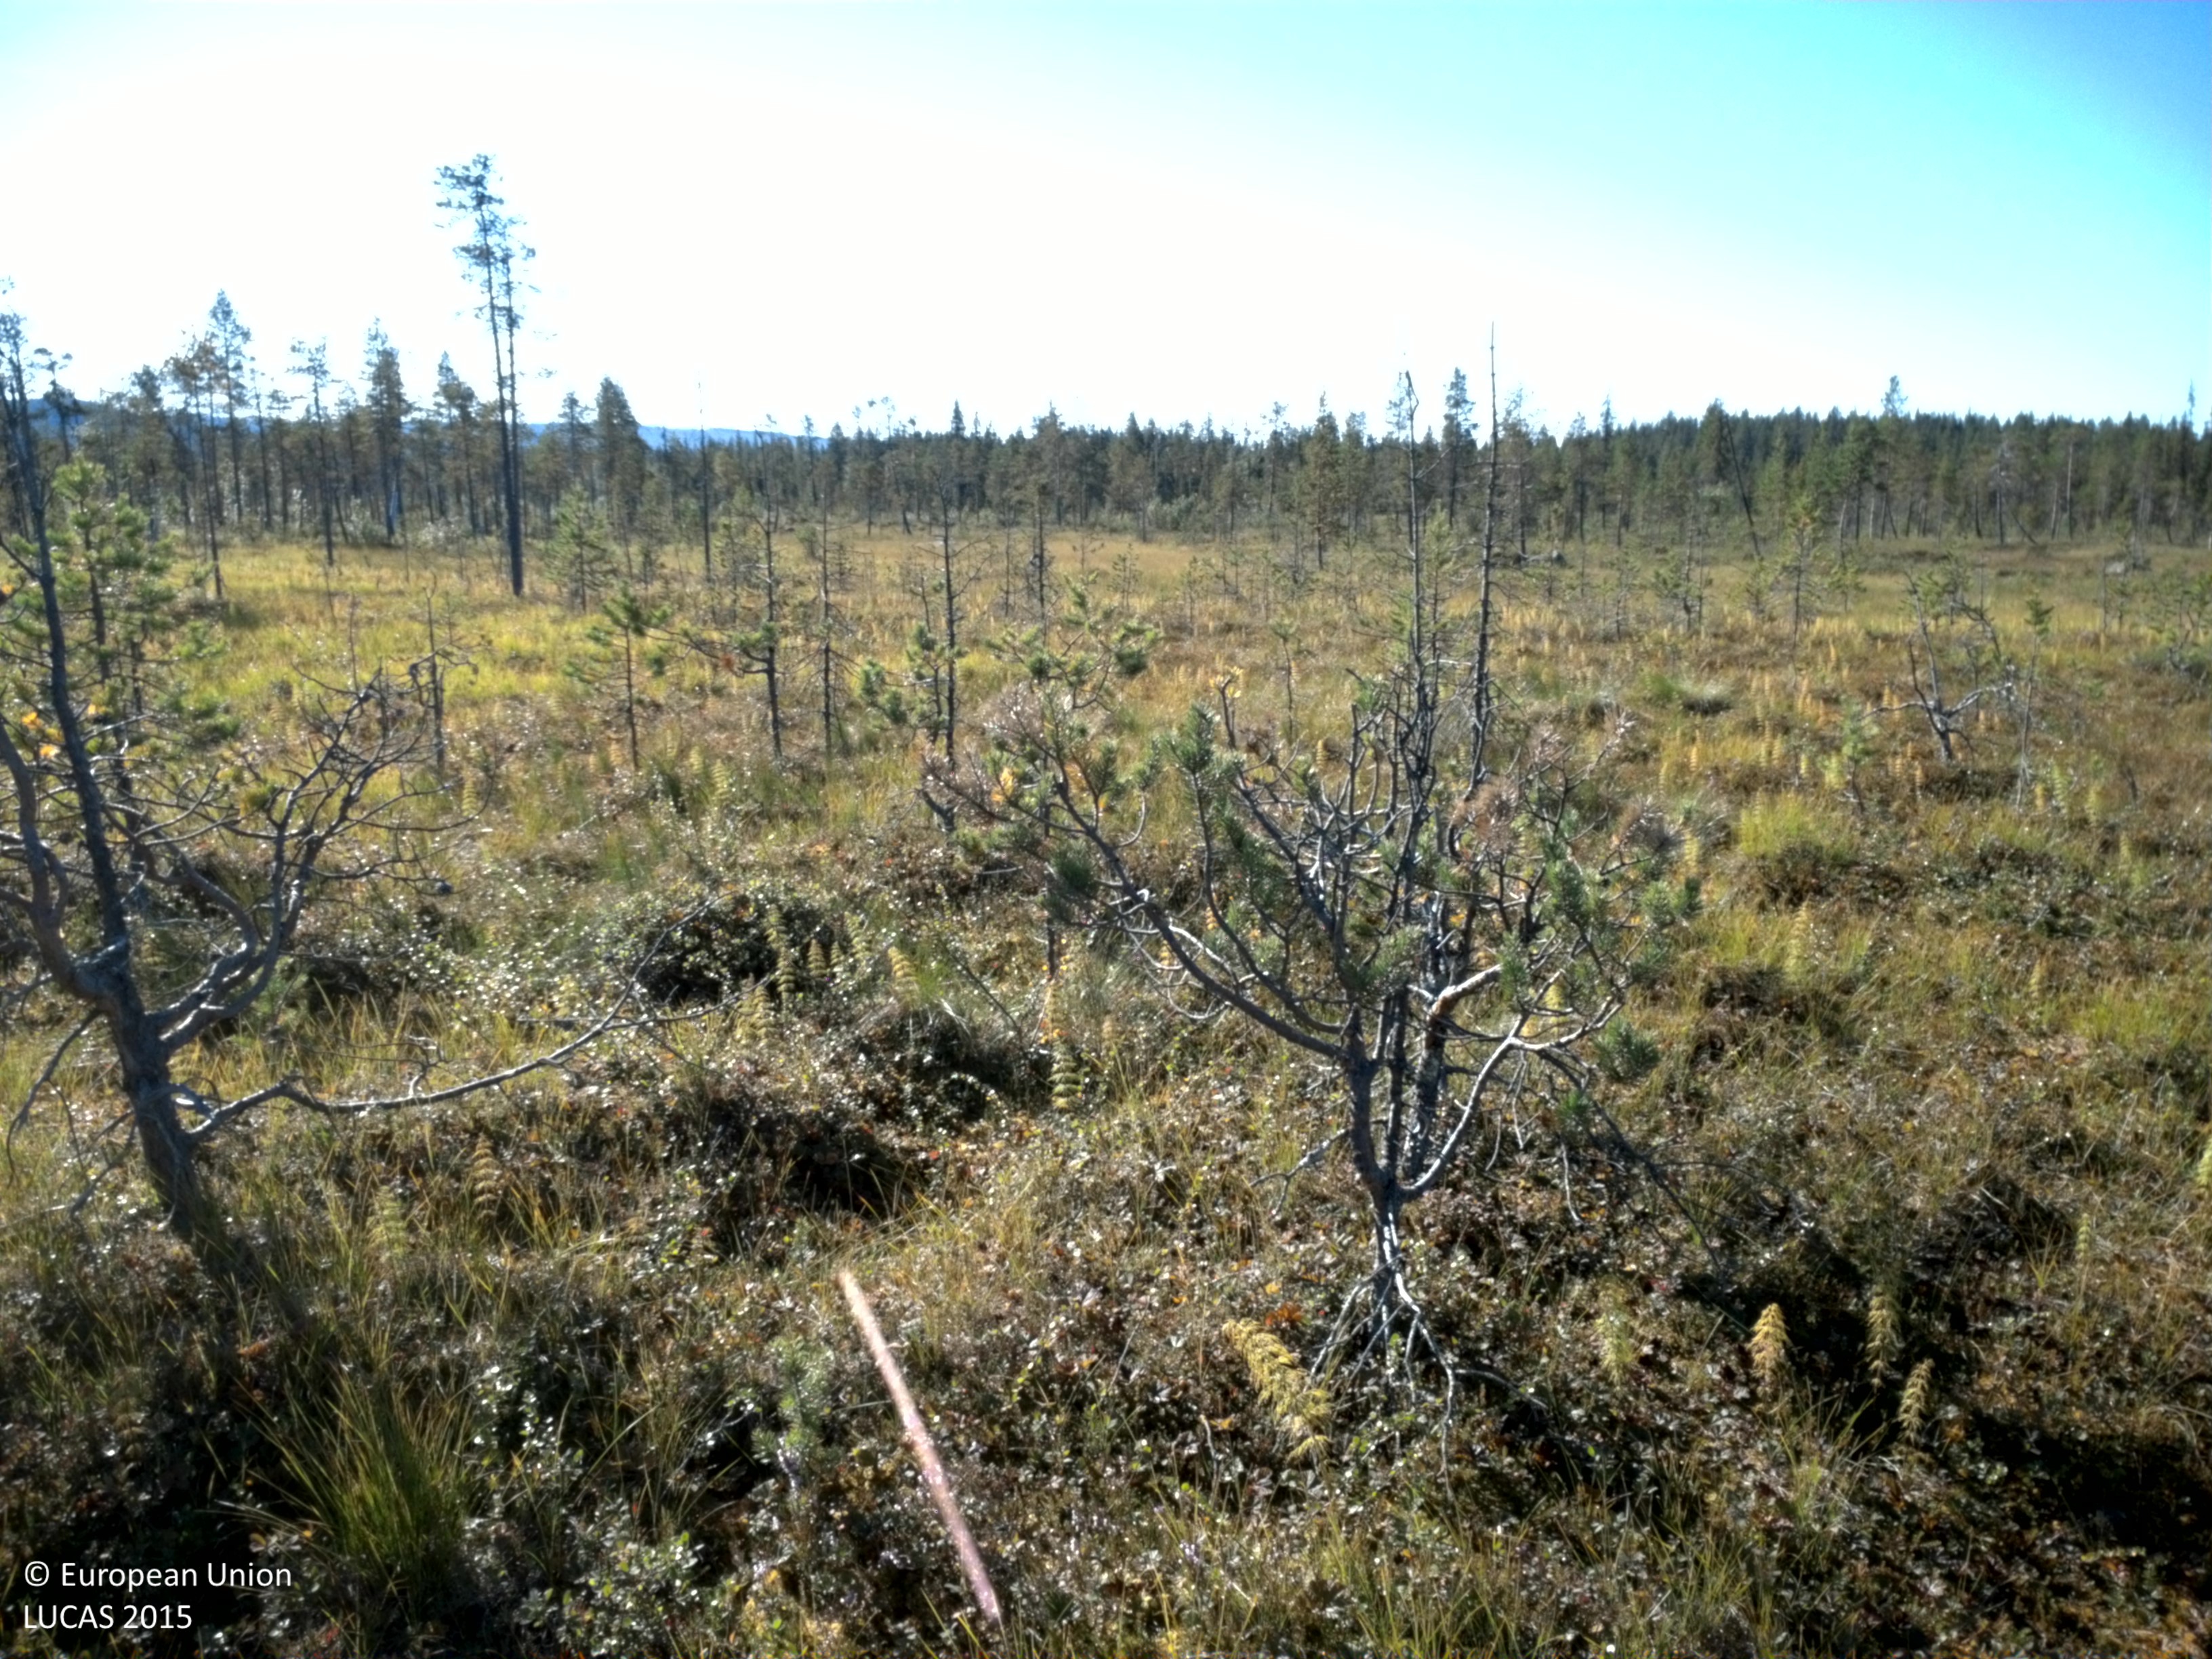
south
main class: Shrubland
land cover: Shrubland with sparse tree cover
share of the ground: 50 - 75 %
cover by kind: shrubs 60 %, herbaceous plants 35 %, coniferous forest trees 5 %
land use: Semi-natural and natural areas not in use
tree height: < 5 m
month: August
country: SE
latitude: 66.7410
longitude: 19.4584
